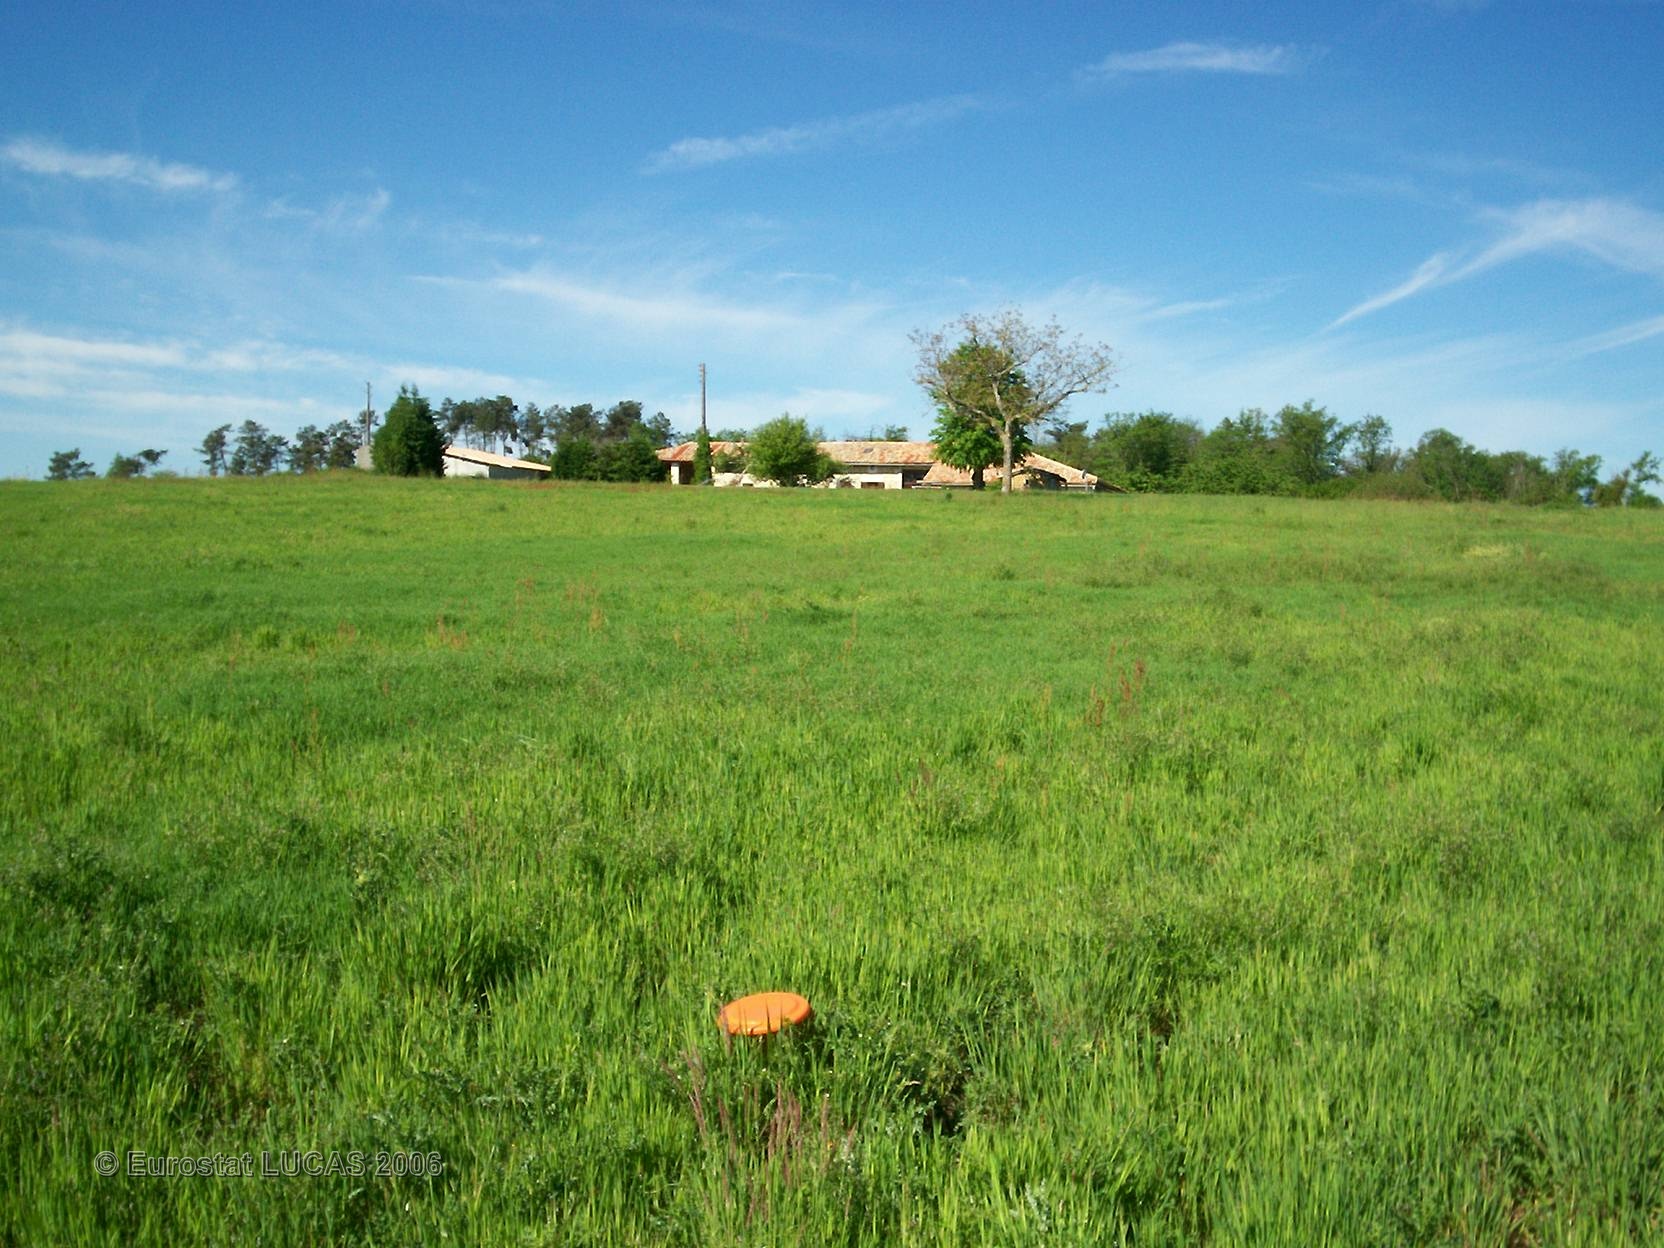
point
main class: Grassland
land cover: Grassland without tree/shrub cover
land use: Agriculture (excluding fallow land and kitchen gardens)
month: May
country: FR
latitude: 45.3801
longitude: -0.1189
